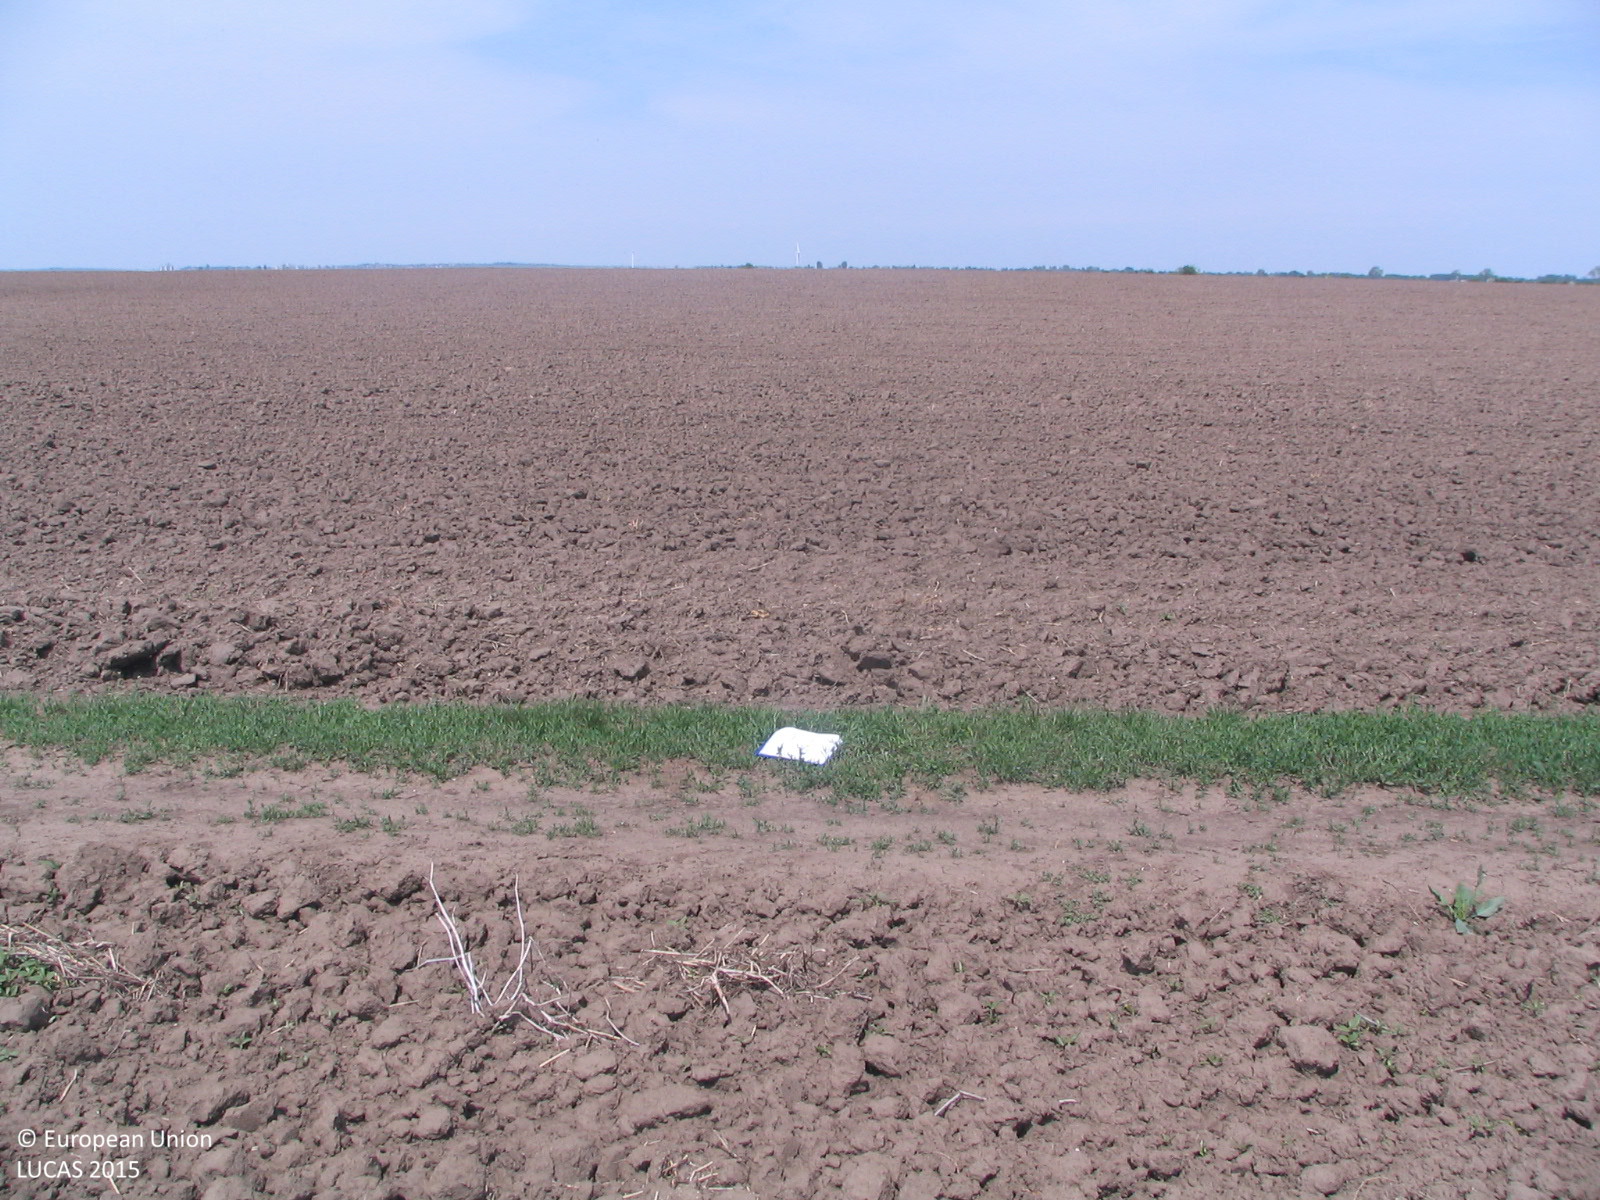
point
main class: Cropland
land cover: Sunflower
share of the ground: < 10 %
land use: Agriculture (excluding fallow land and kitchen gardens)
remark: Harvested field
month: May
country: BG
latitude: 43.6373
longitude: 23.9739
